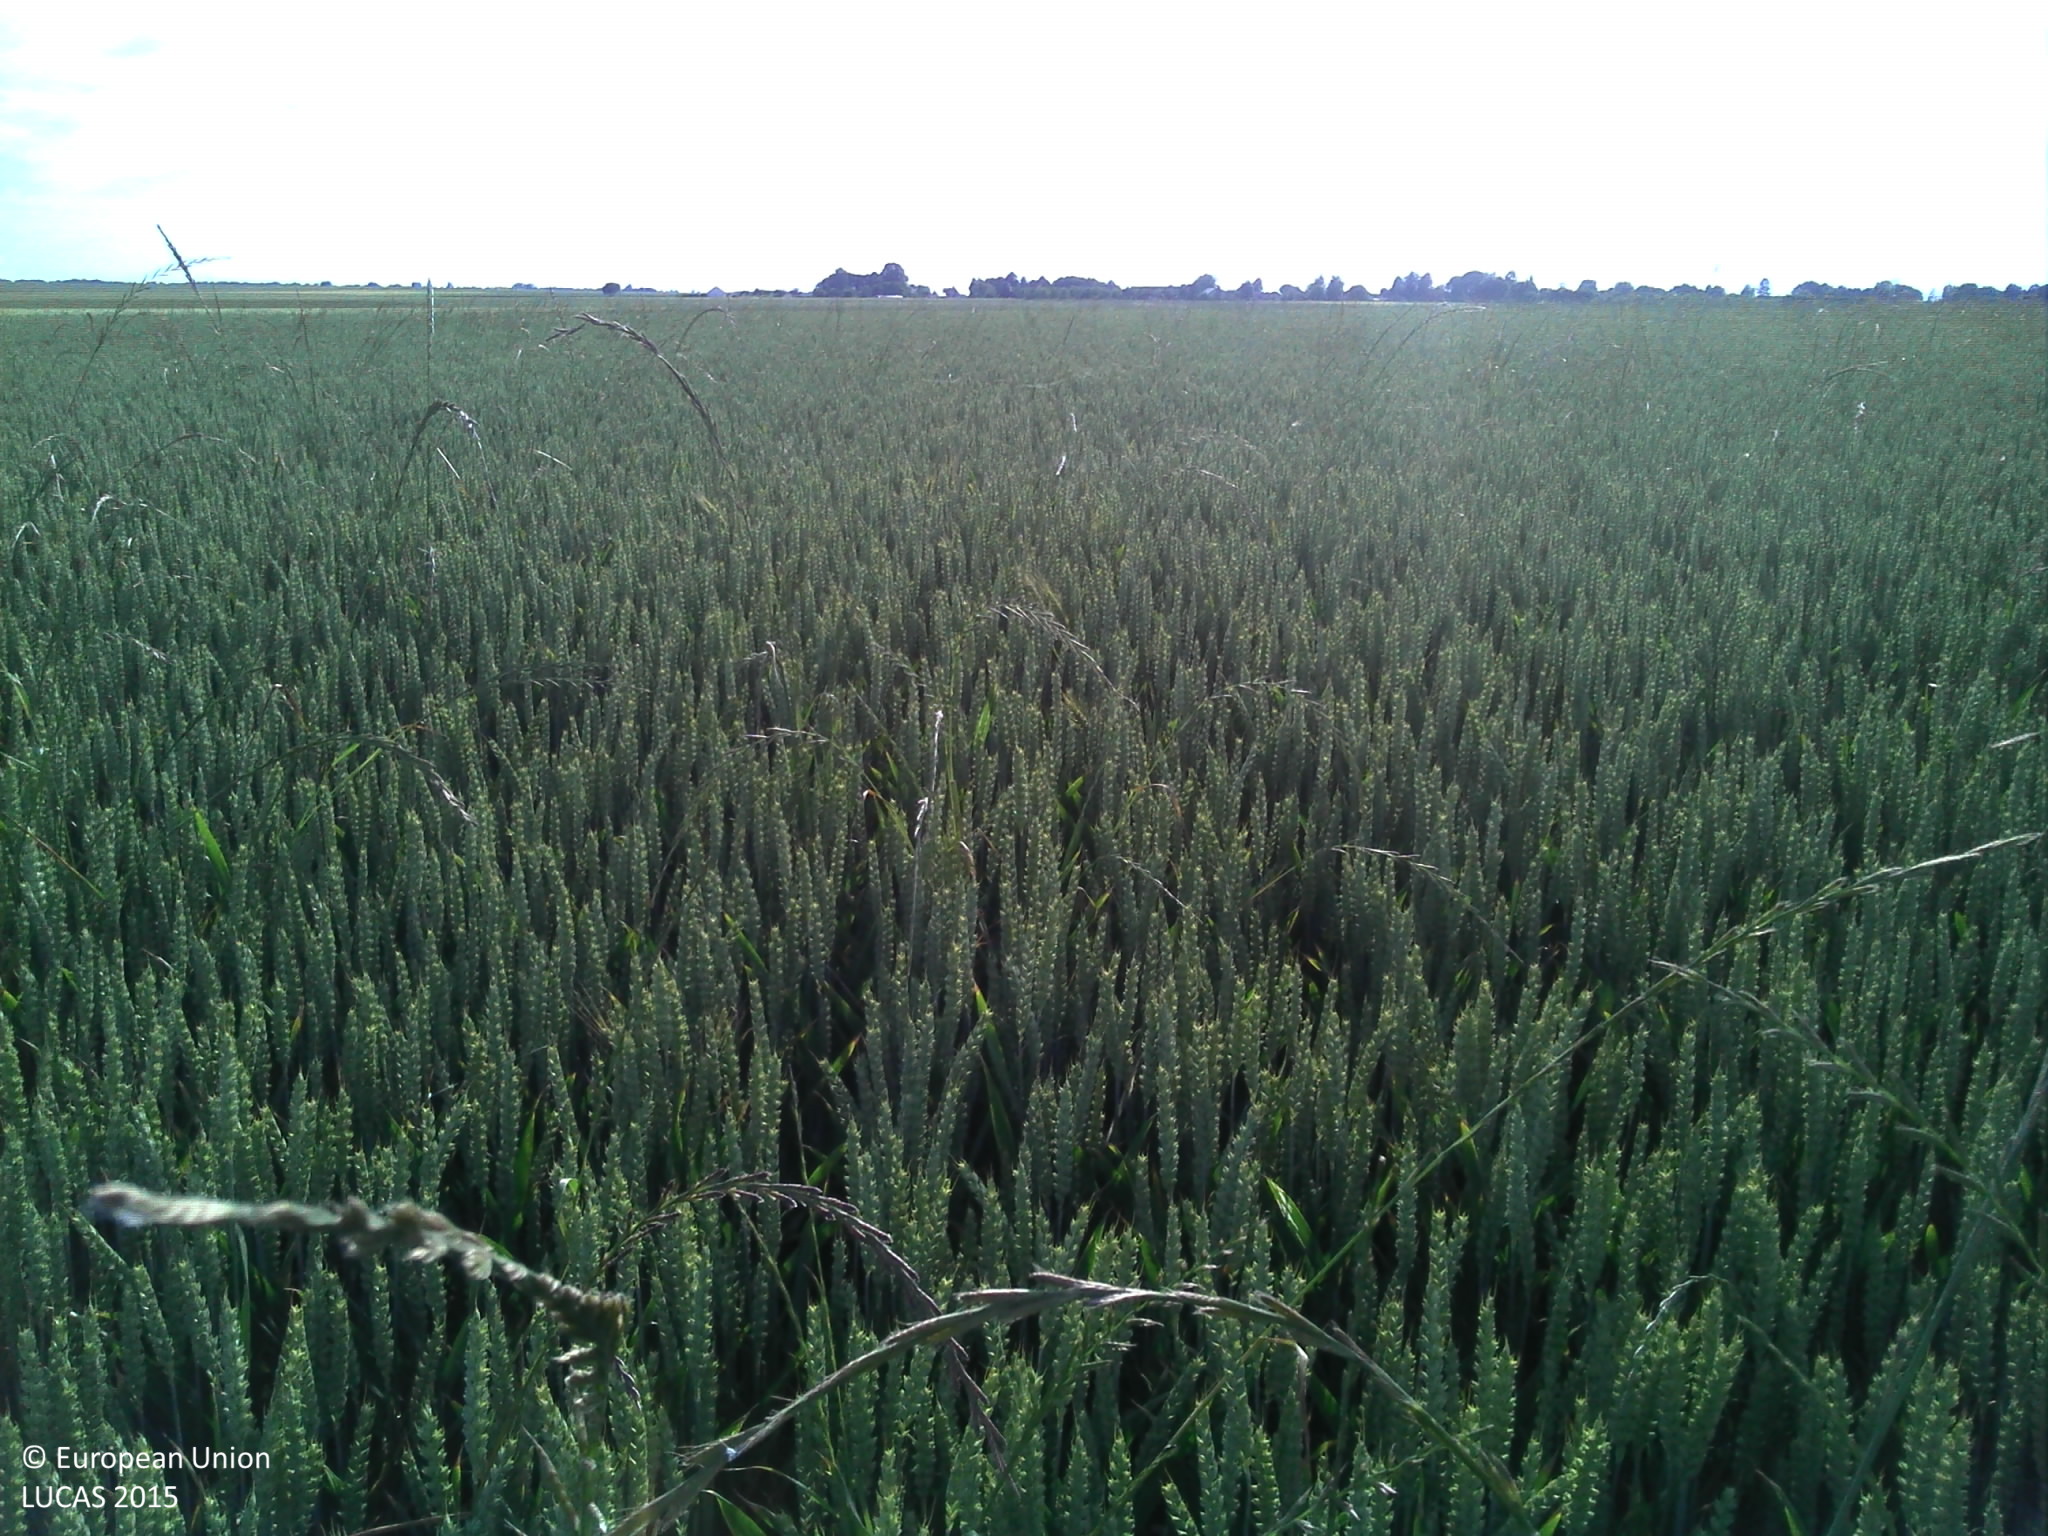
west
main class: Cropland
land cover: Common wheat
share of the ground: > 75 %
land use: Agriculture (excluding fallow land and kitchen gardens)
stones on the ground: < 10 %
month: June
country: FR
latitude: 49.2001
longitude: 1.0718
